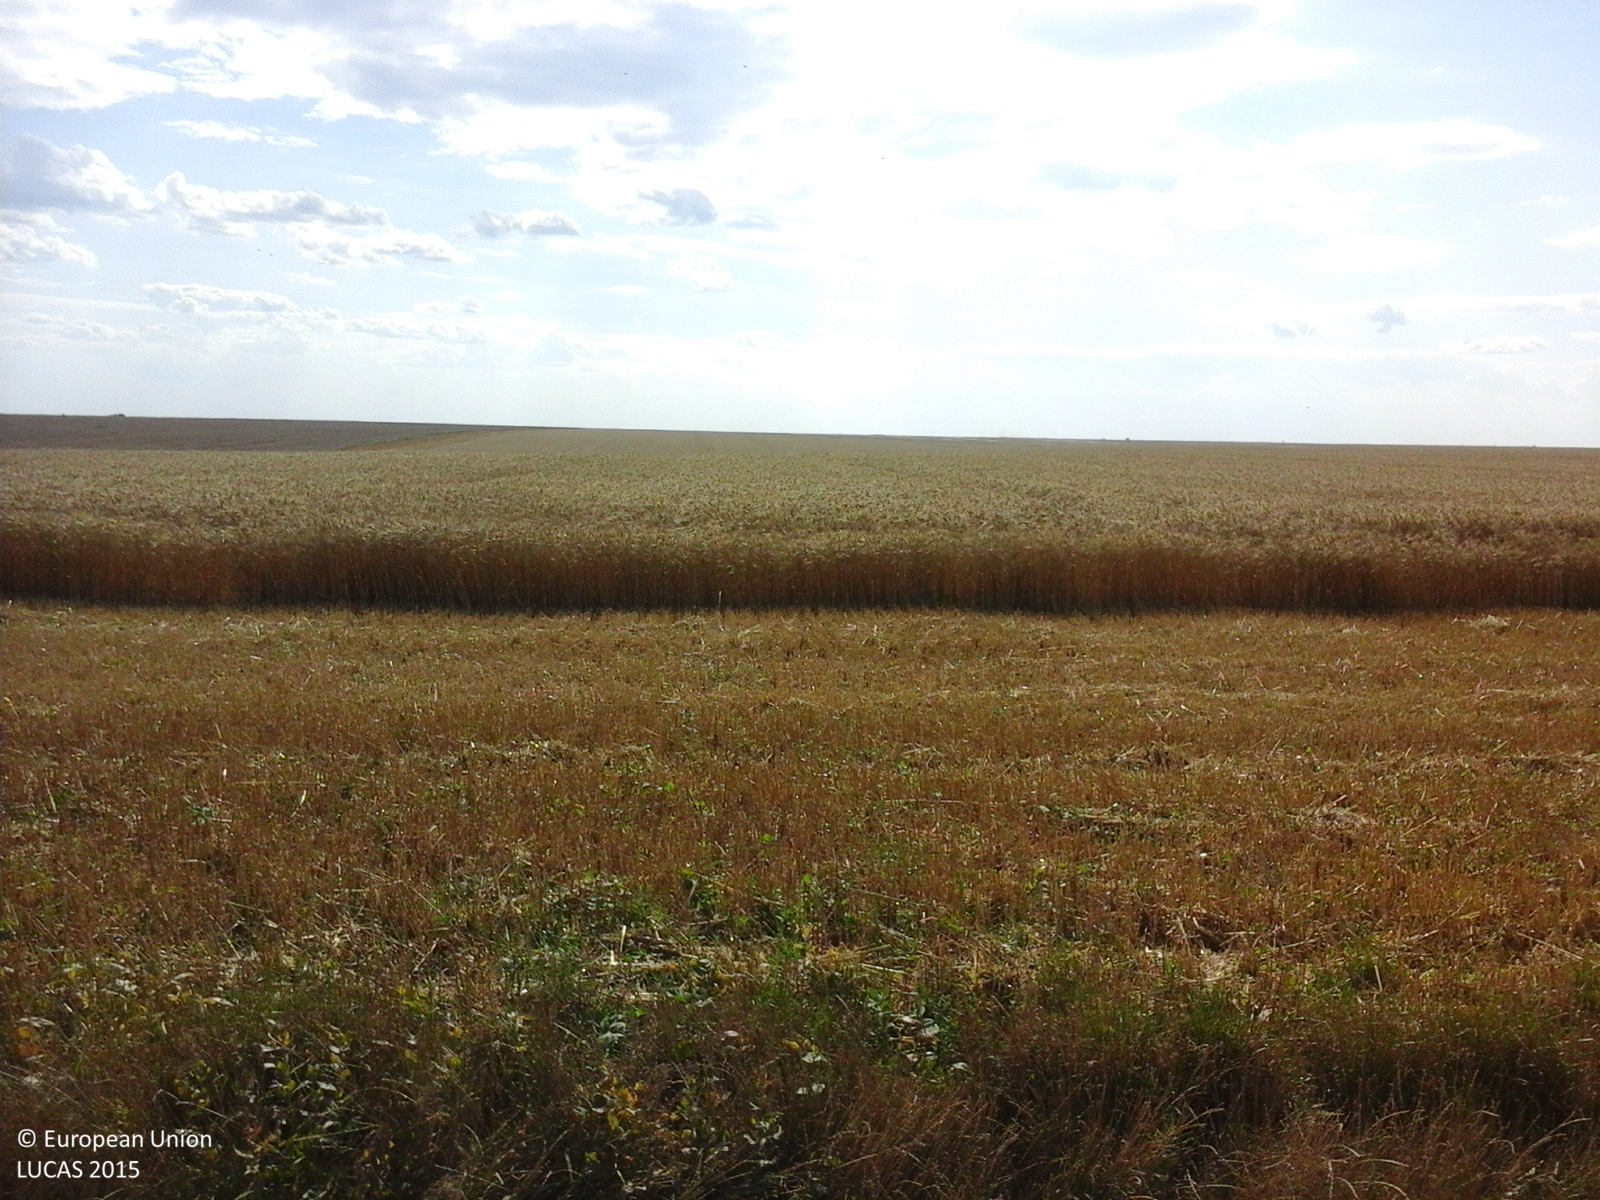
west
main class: Cropland
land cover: Sunflower
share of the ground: > 75 %
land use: Agriculture (excluding fallow land and kitchen gardens)
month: July
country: RO
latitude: 44.0777
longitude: 24.8717
